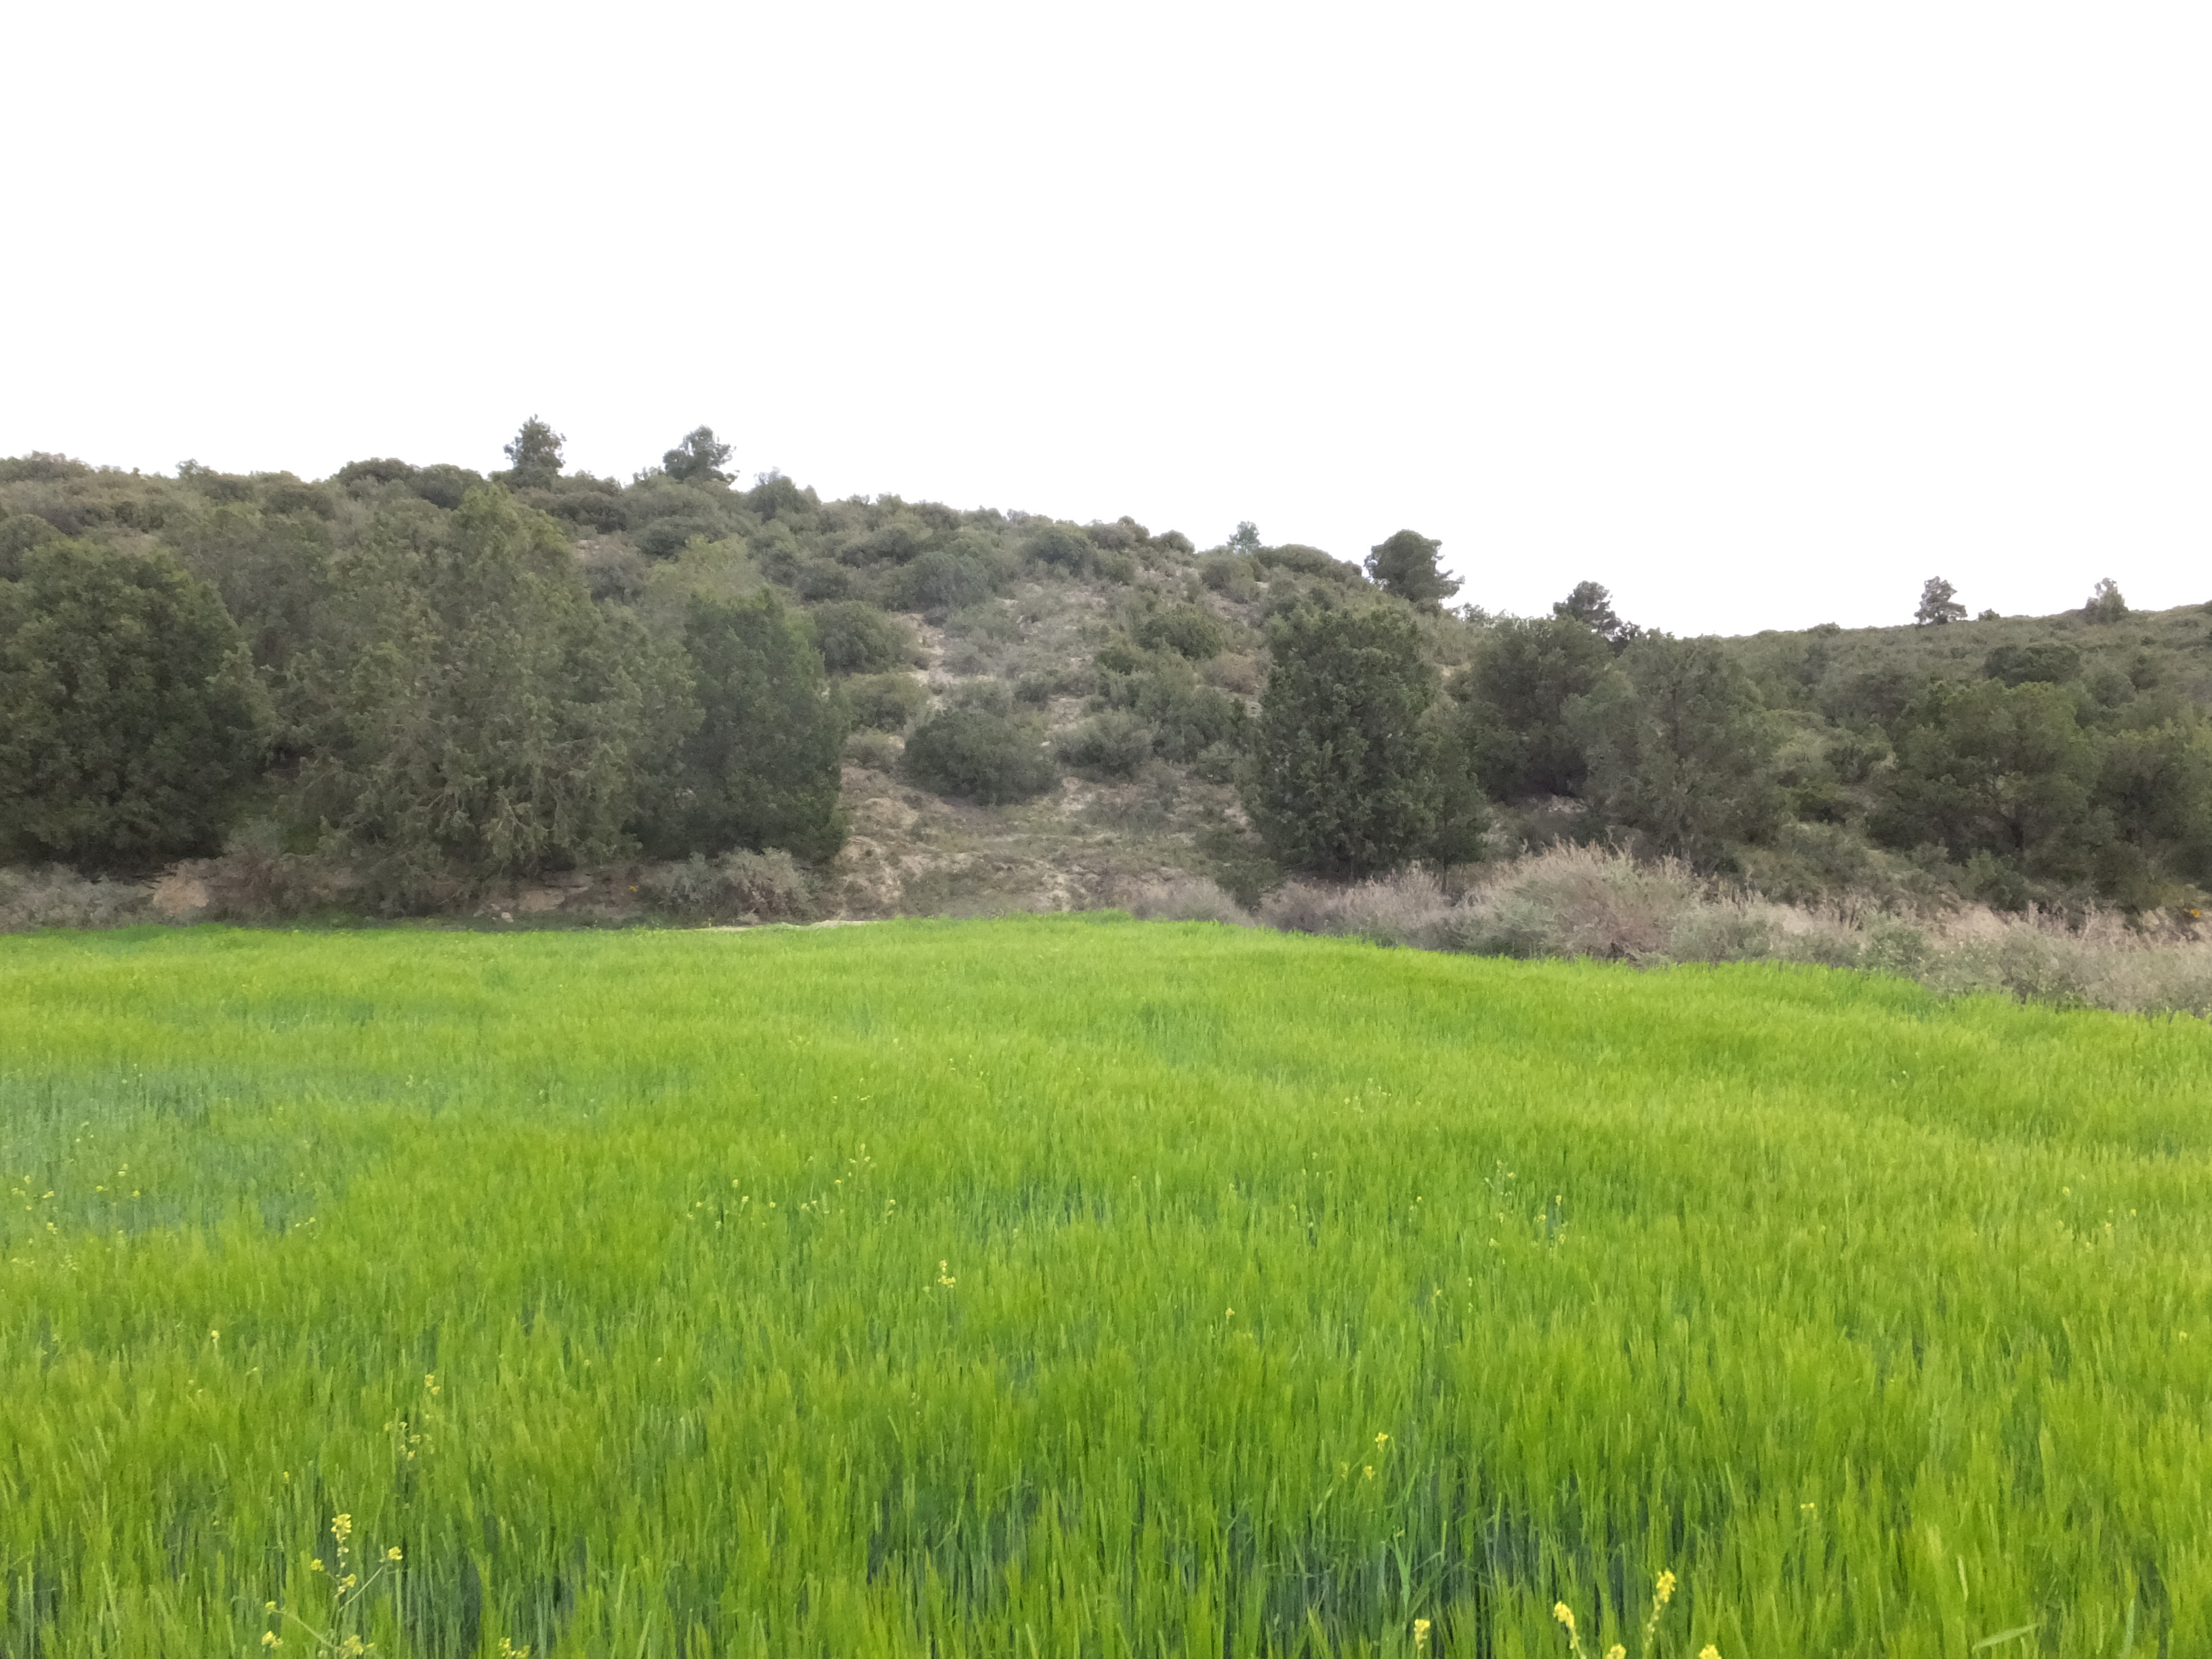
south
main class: Cropland
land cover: Barley
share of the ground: > 75 %
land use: Agriculture (excluding fallow land and kitchen gardens)
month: April
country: ES
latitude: 41.6585
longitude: -0.2610
